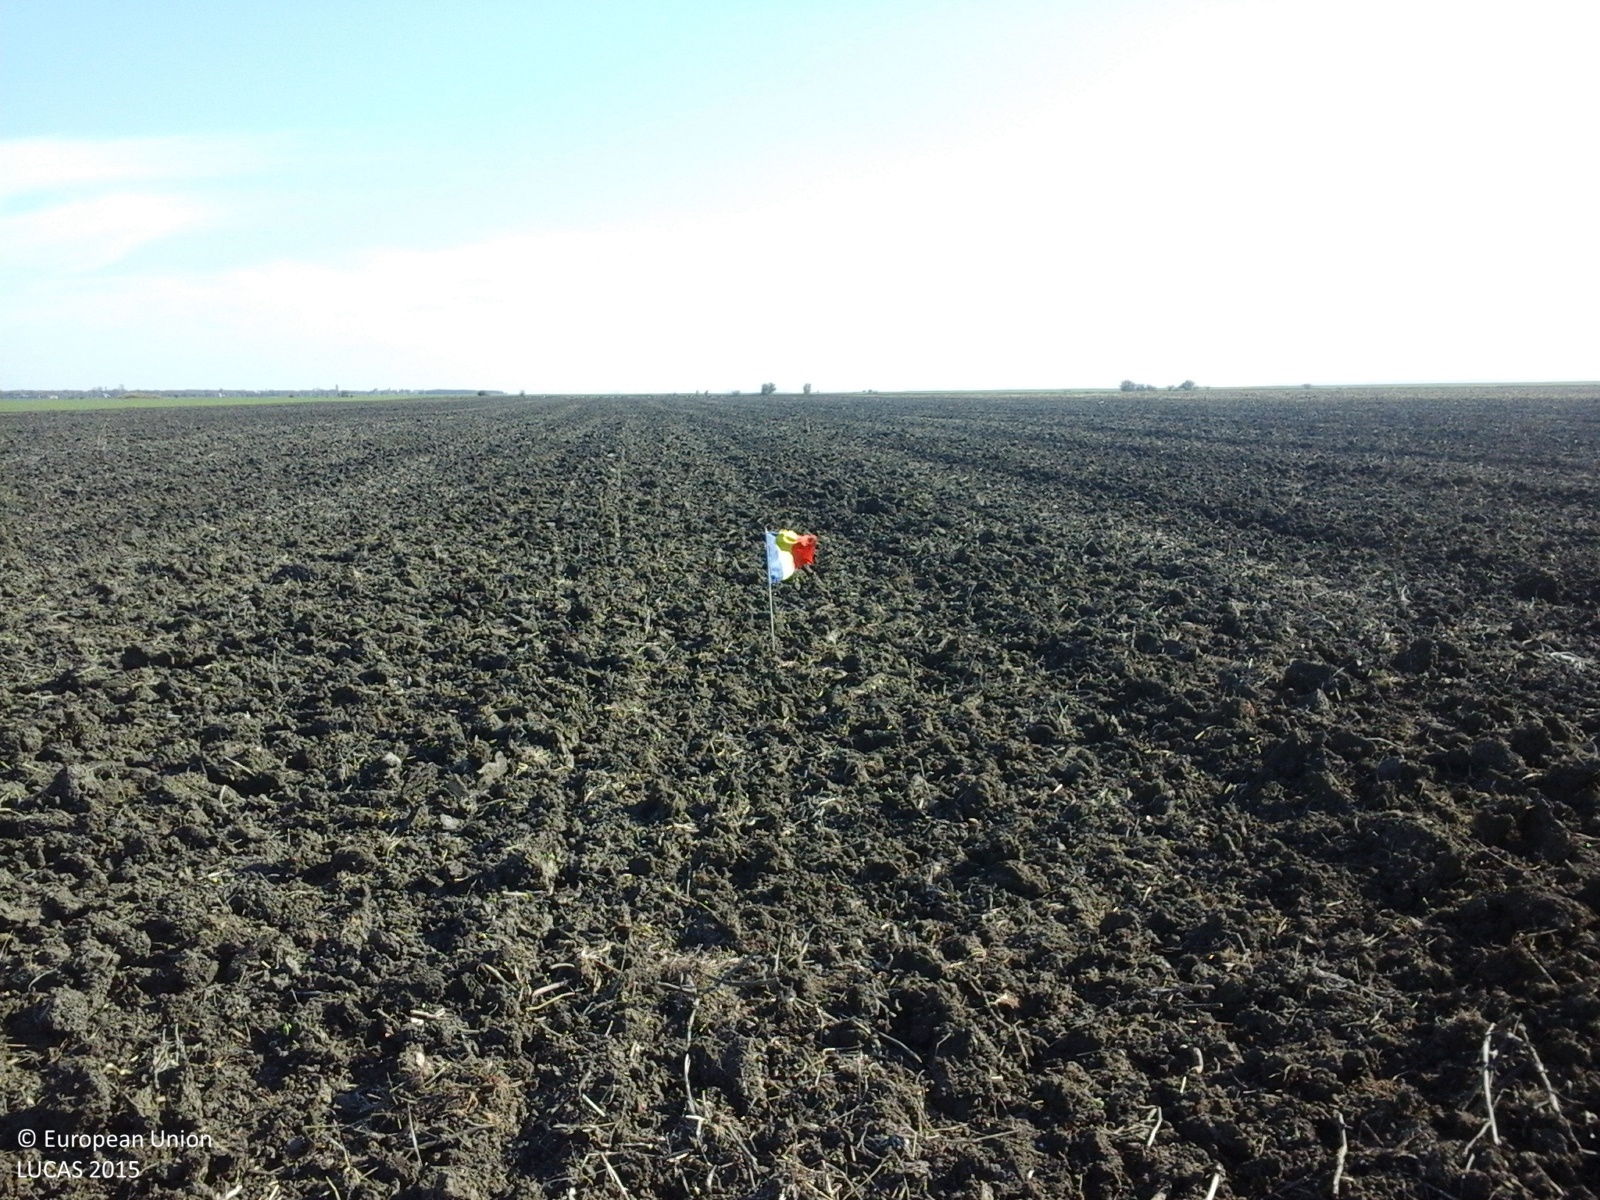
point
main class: Cropland
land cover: Rape and turnip rape
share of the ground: < 10 %
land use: Agriculture (excluding fallow land and kitchen gardens)
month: October
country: RO
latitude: 45.4061
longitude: 27.4109
